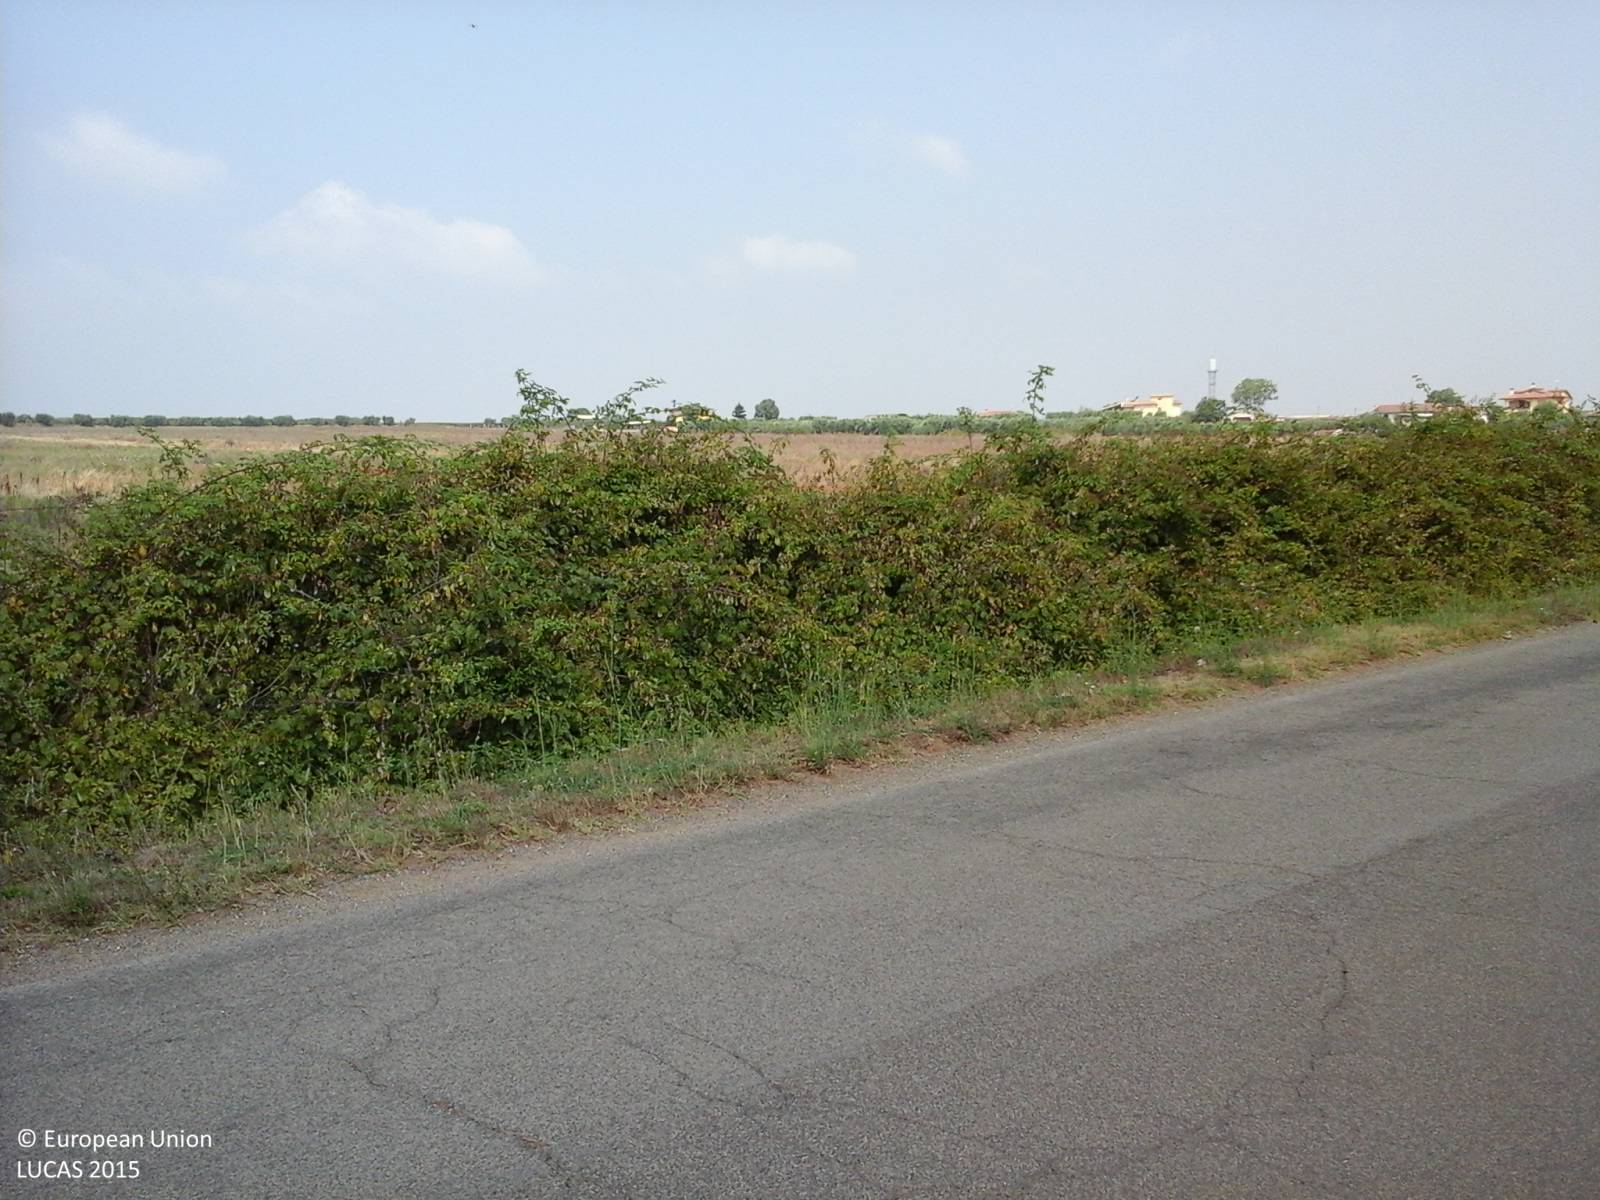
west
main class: Cropland
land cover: Vineyards
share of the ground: > 75 %
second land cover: Spontaneously vegetated surfaces
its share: > 75 %
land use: Agriculture (excluding fallow land and kitchen gardens)
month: July
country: IT
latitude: 41.5143
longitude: 12.7330
